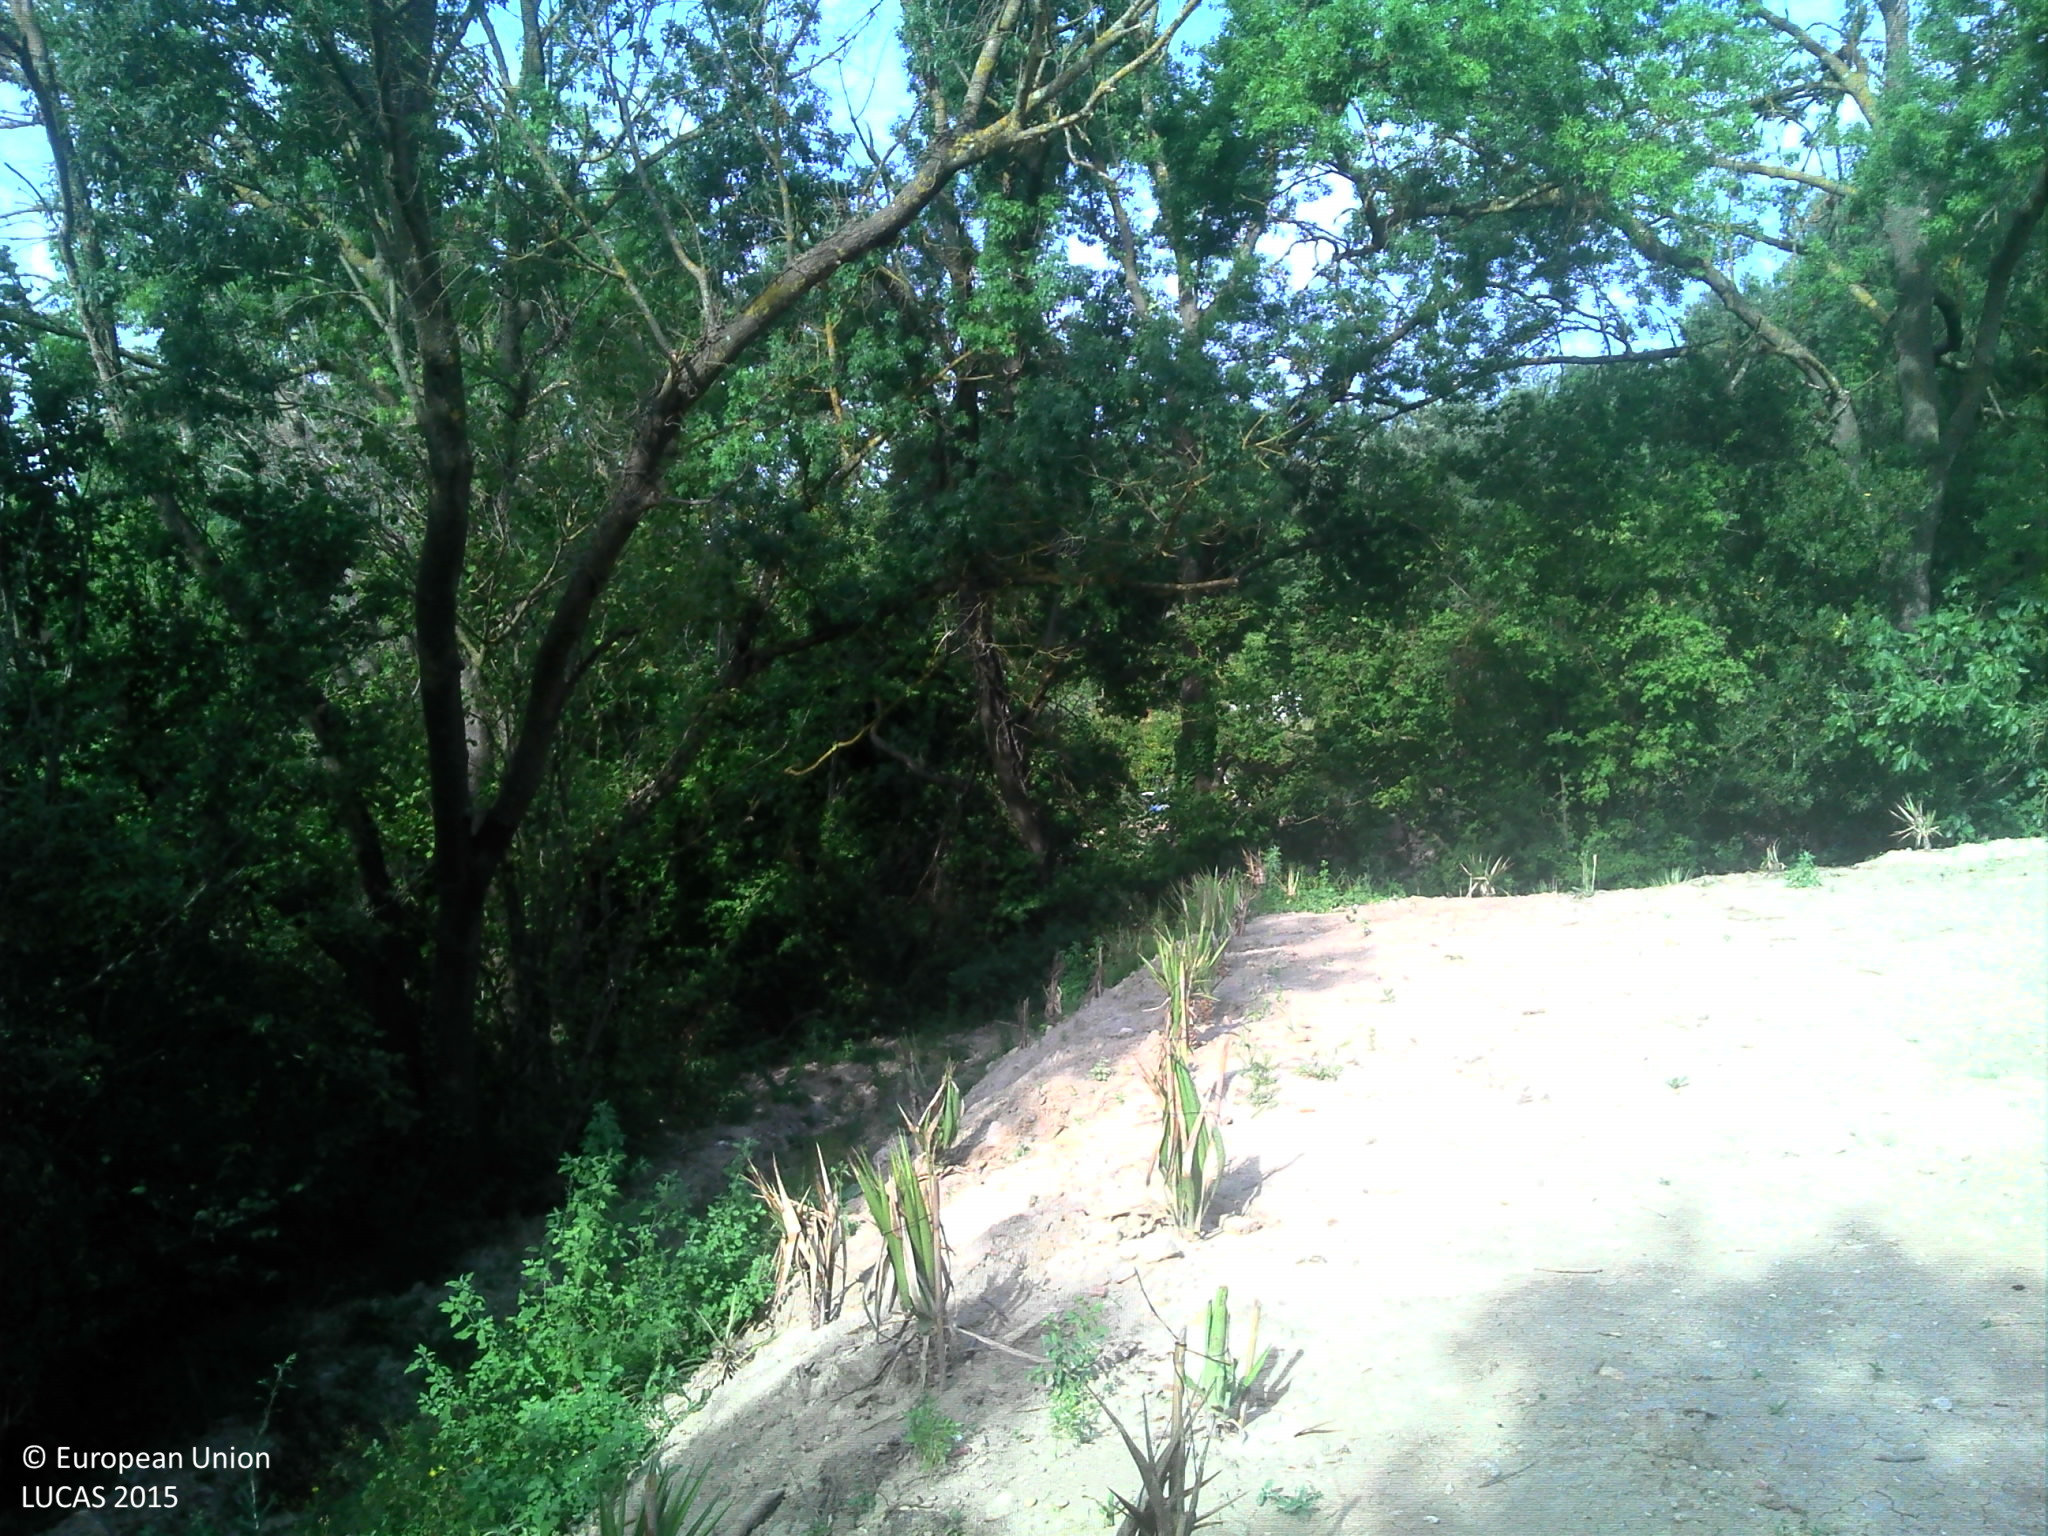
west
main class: Woodland
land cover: Broadleaved woodland
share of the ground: > 75 %
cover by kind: broadleaved forest trees 80 %
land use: Semi-natural and natural areas not in use
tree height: < 5 m
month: July
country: FR
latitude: 43.6176
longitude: 5.0406
